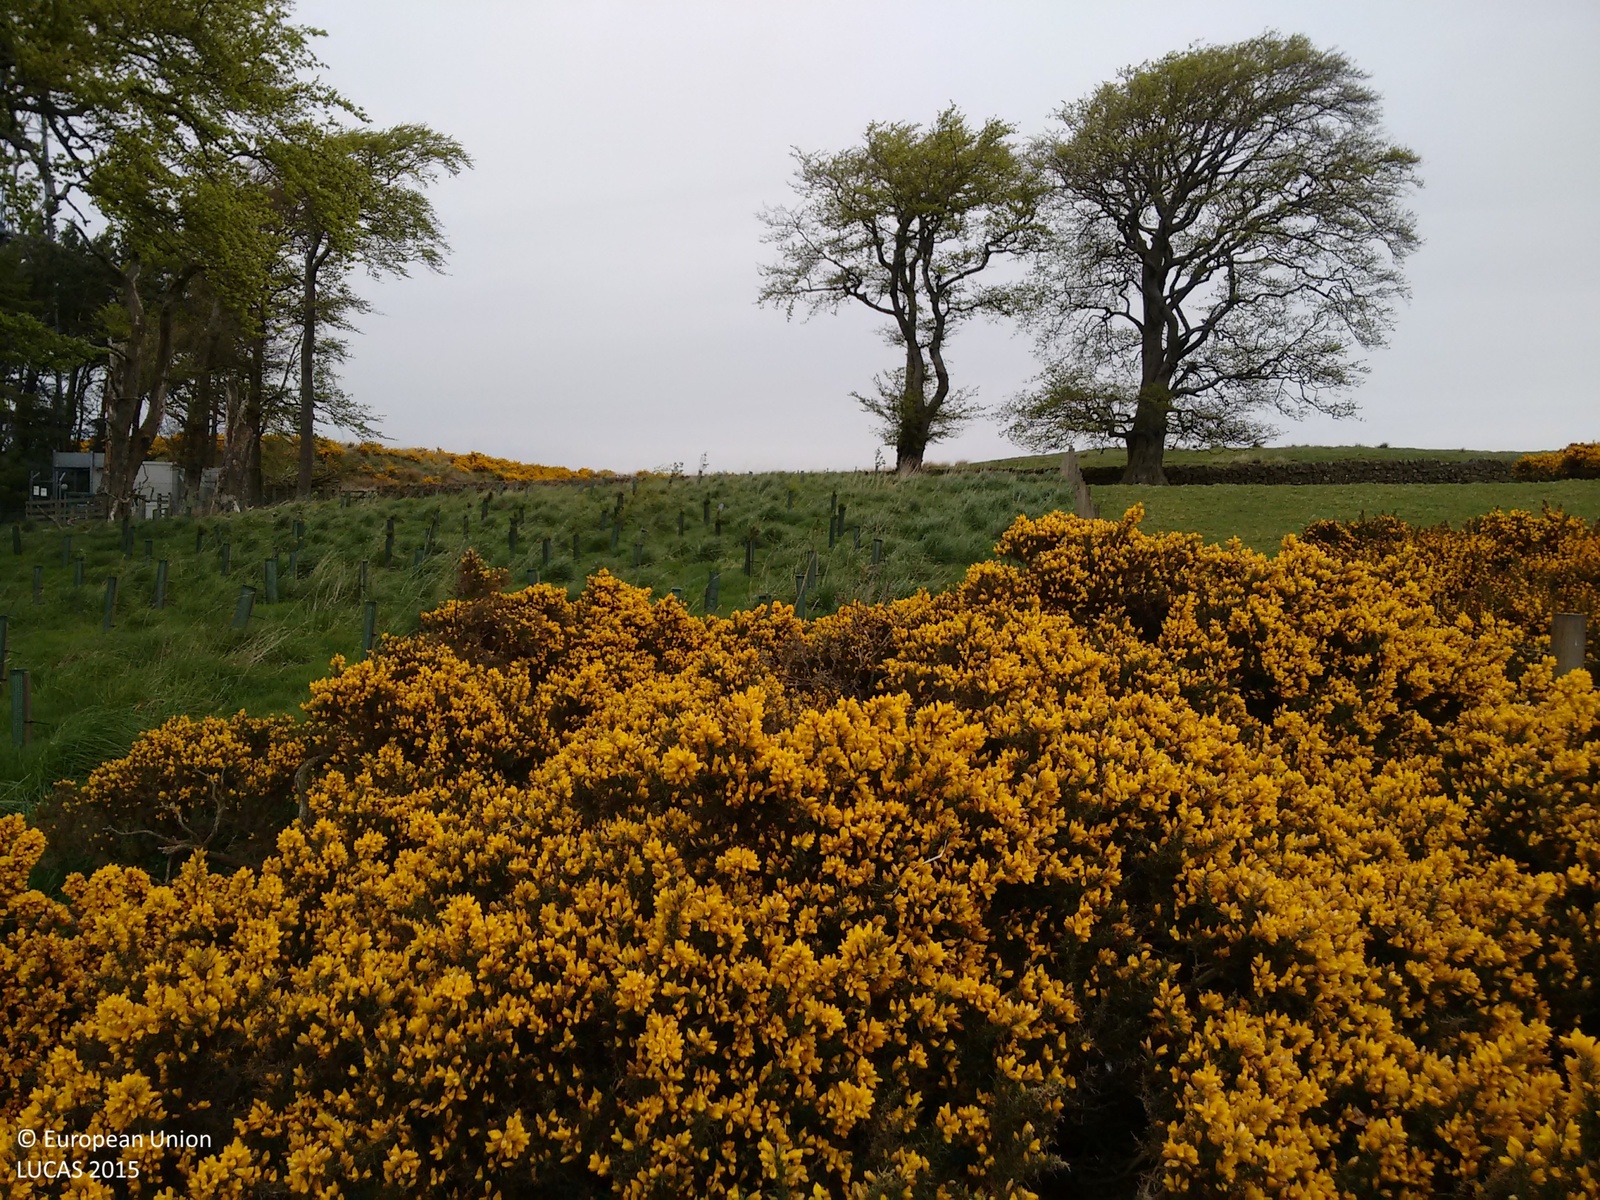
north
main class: Grassland
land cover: Grassland with sparse tree/shrub cover
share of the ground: > 75 %
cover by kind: herbaceous plants 90 %, broadleaved forest trees 5 %, shrubs 5 %
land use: Forestry
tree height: < 5 m
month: May
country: GB
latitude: 55.8864
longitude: -3.3608
